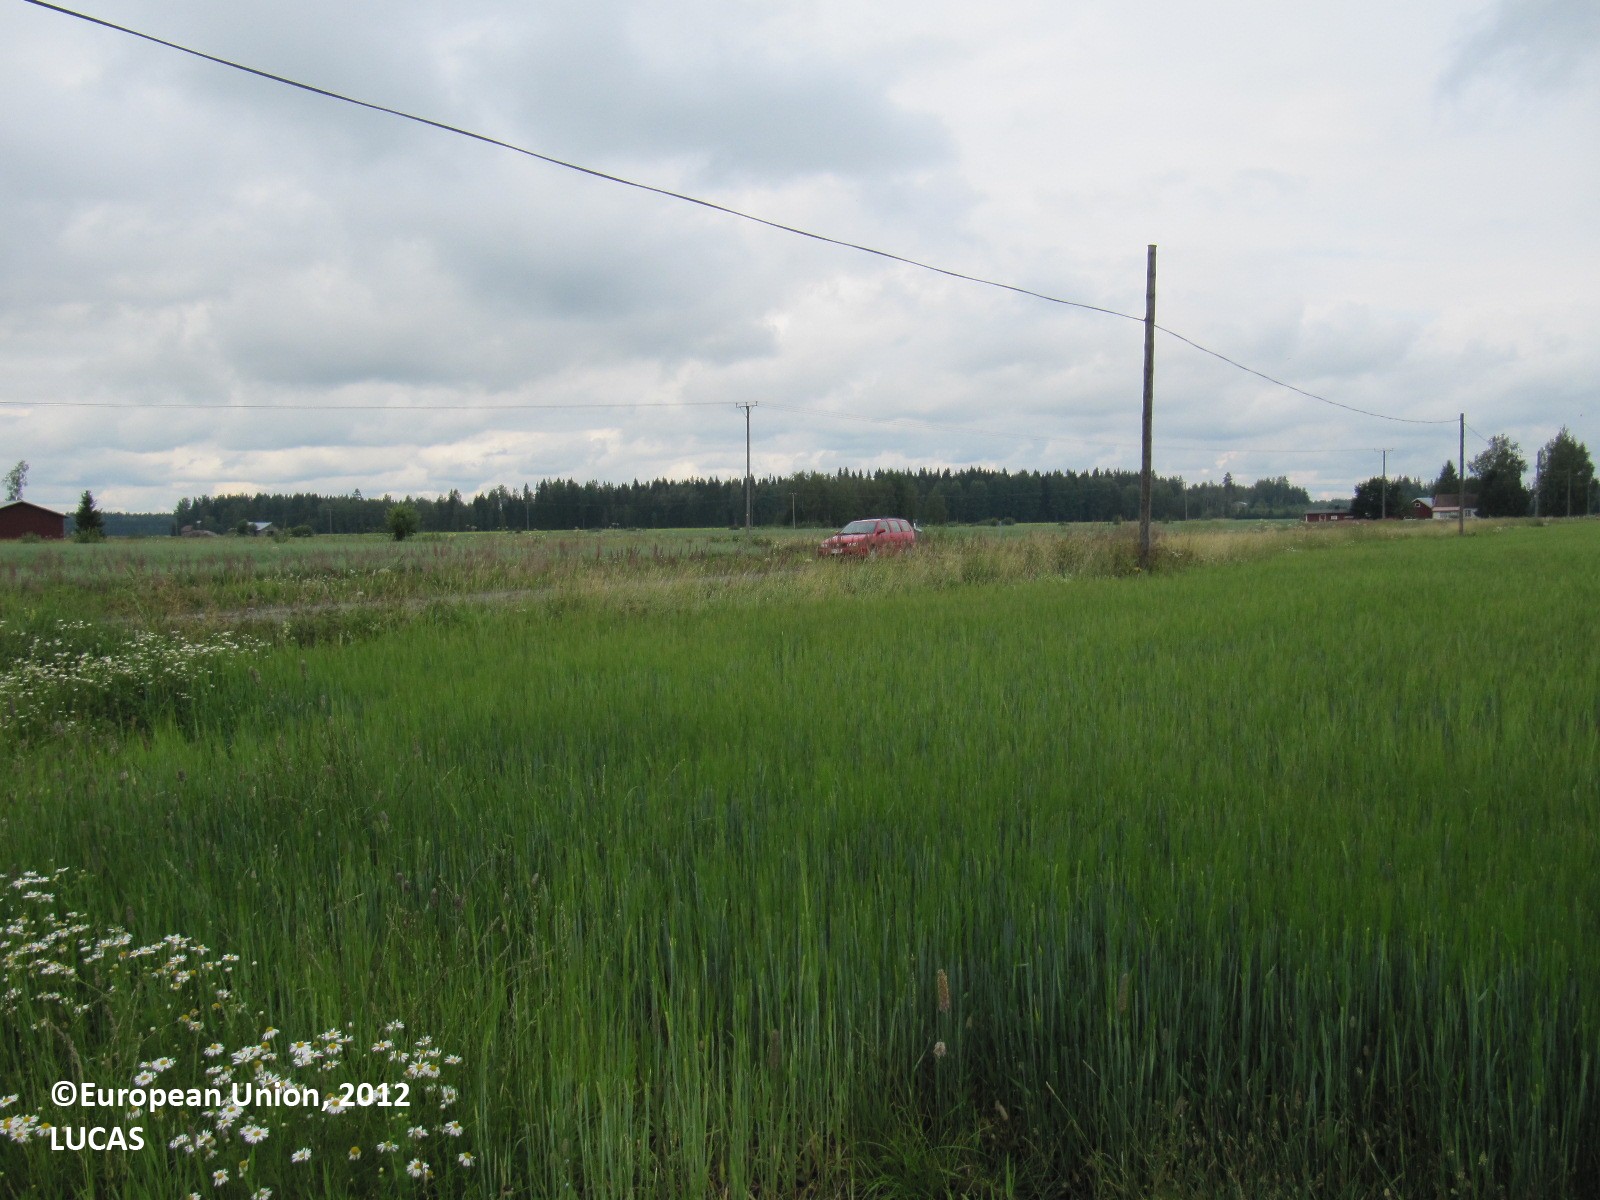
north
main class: Cropland
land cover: Temporary grasslands
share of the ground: > 75 %
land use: Agriculture (excluding fallow land and kitchen gardens)
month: July
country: FI
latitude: 60.7328
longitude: 23.3400
